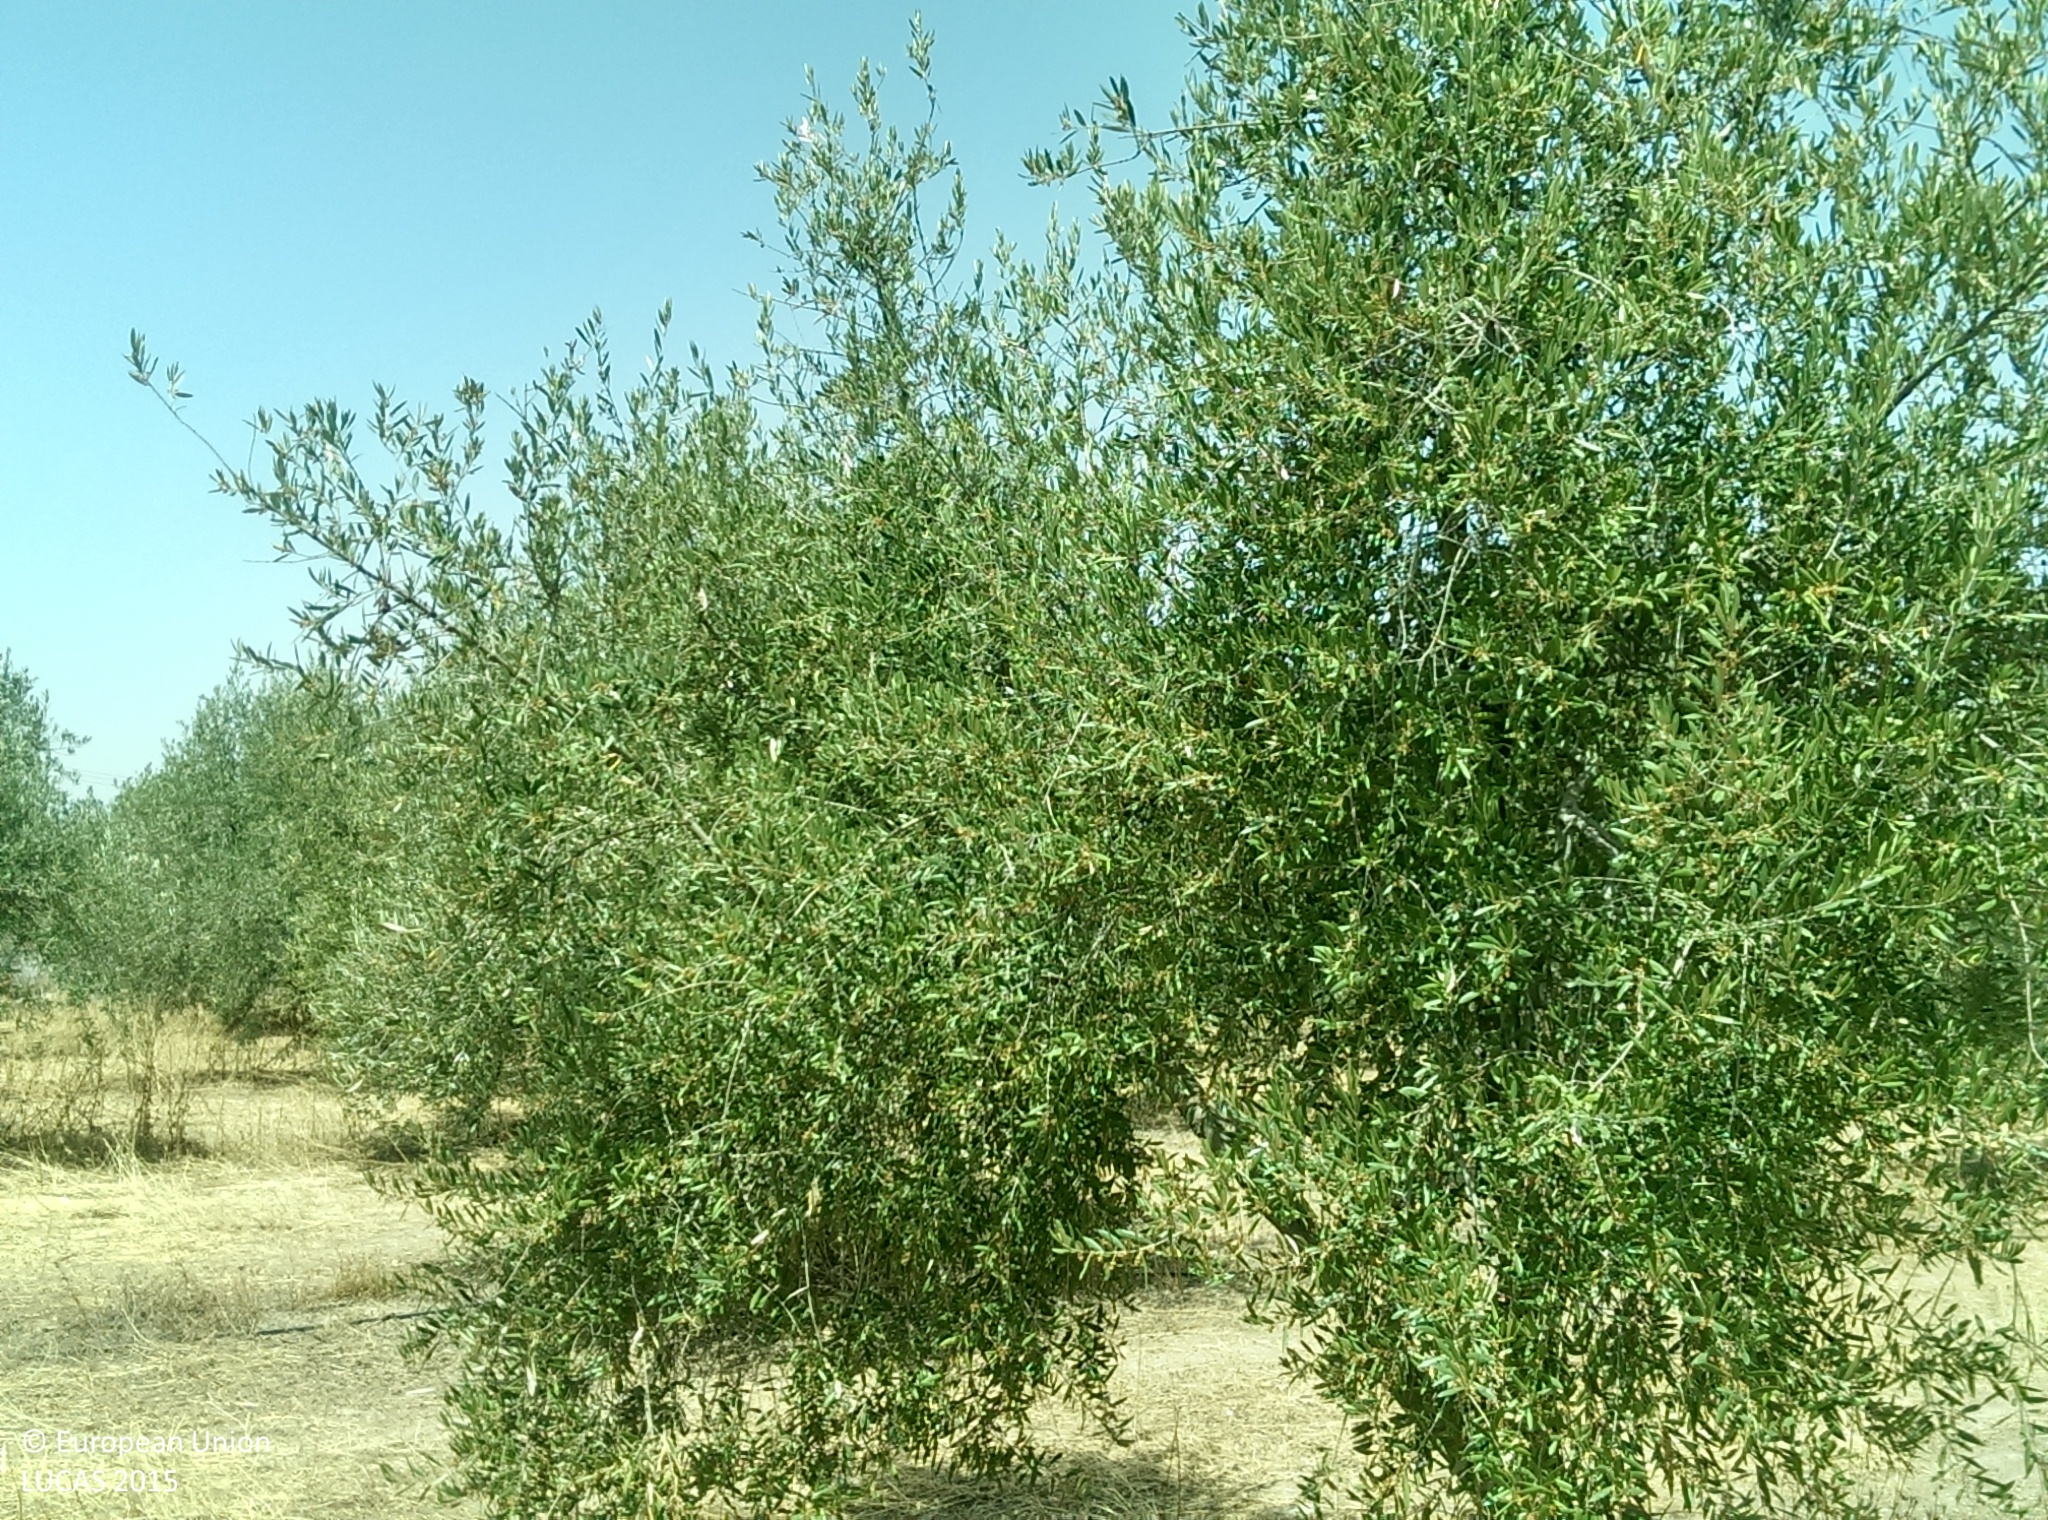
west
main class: Cropland
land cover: Olive groves
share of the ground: 25 - 50 %
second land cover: Spontaneously vegetated surfaces
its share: > 75 %
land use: Agriculture (excluding fallow land and kitchen gardens)
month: July
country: ES
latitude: 37.2273
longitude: -3.7075
